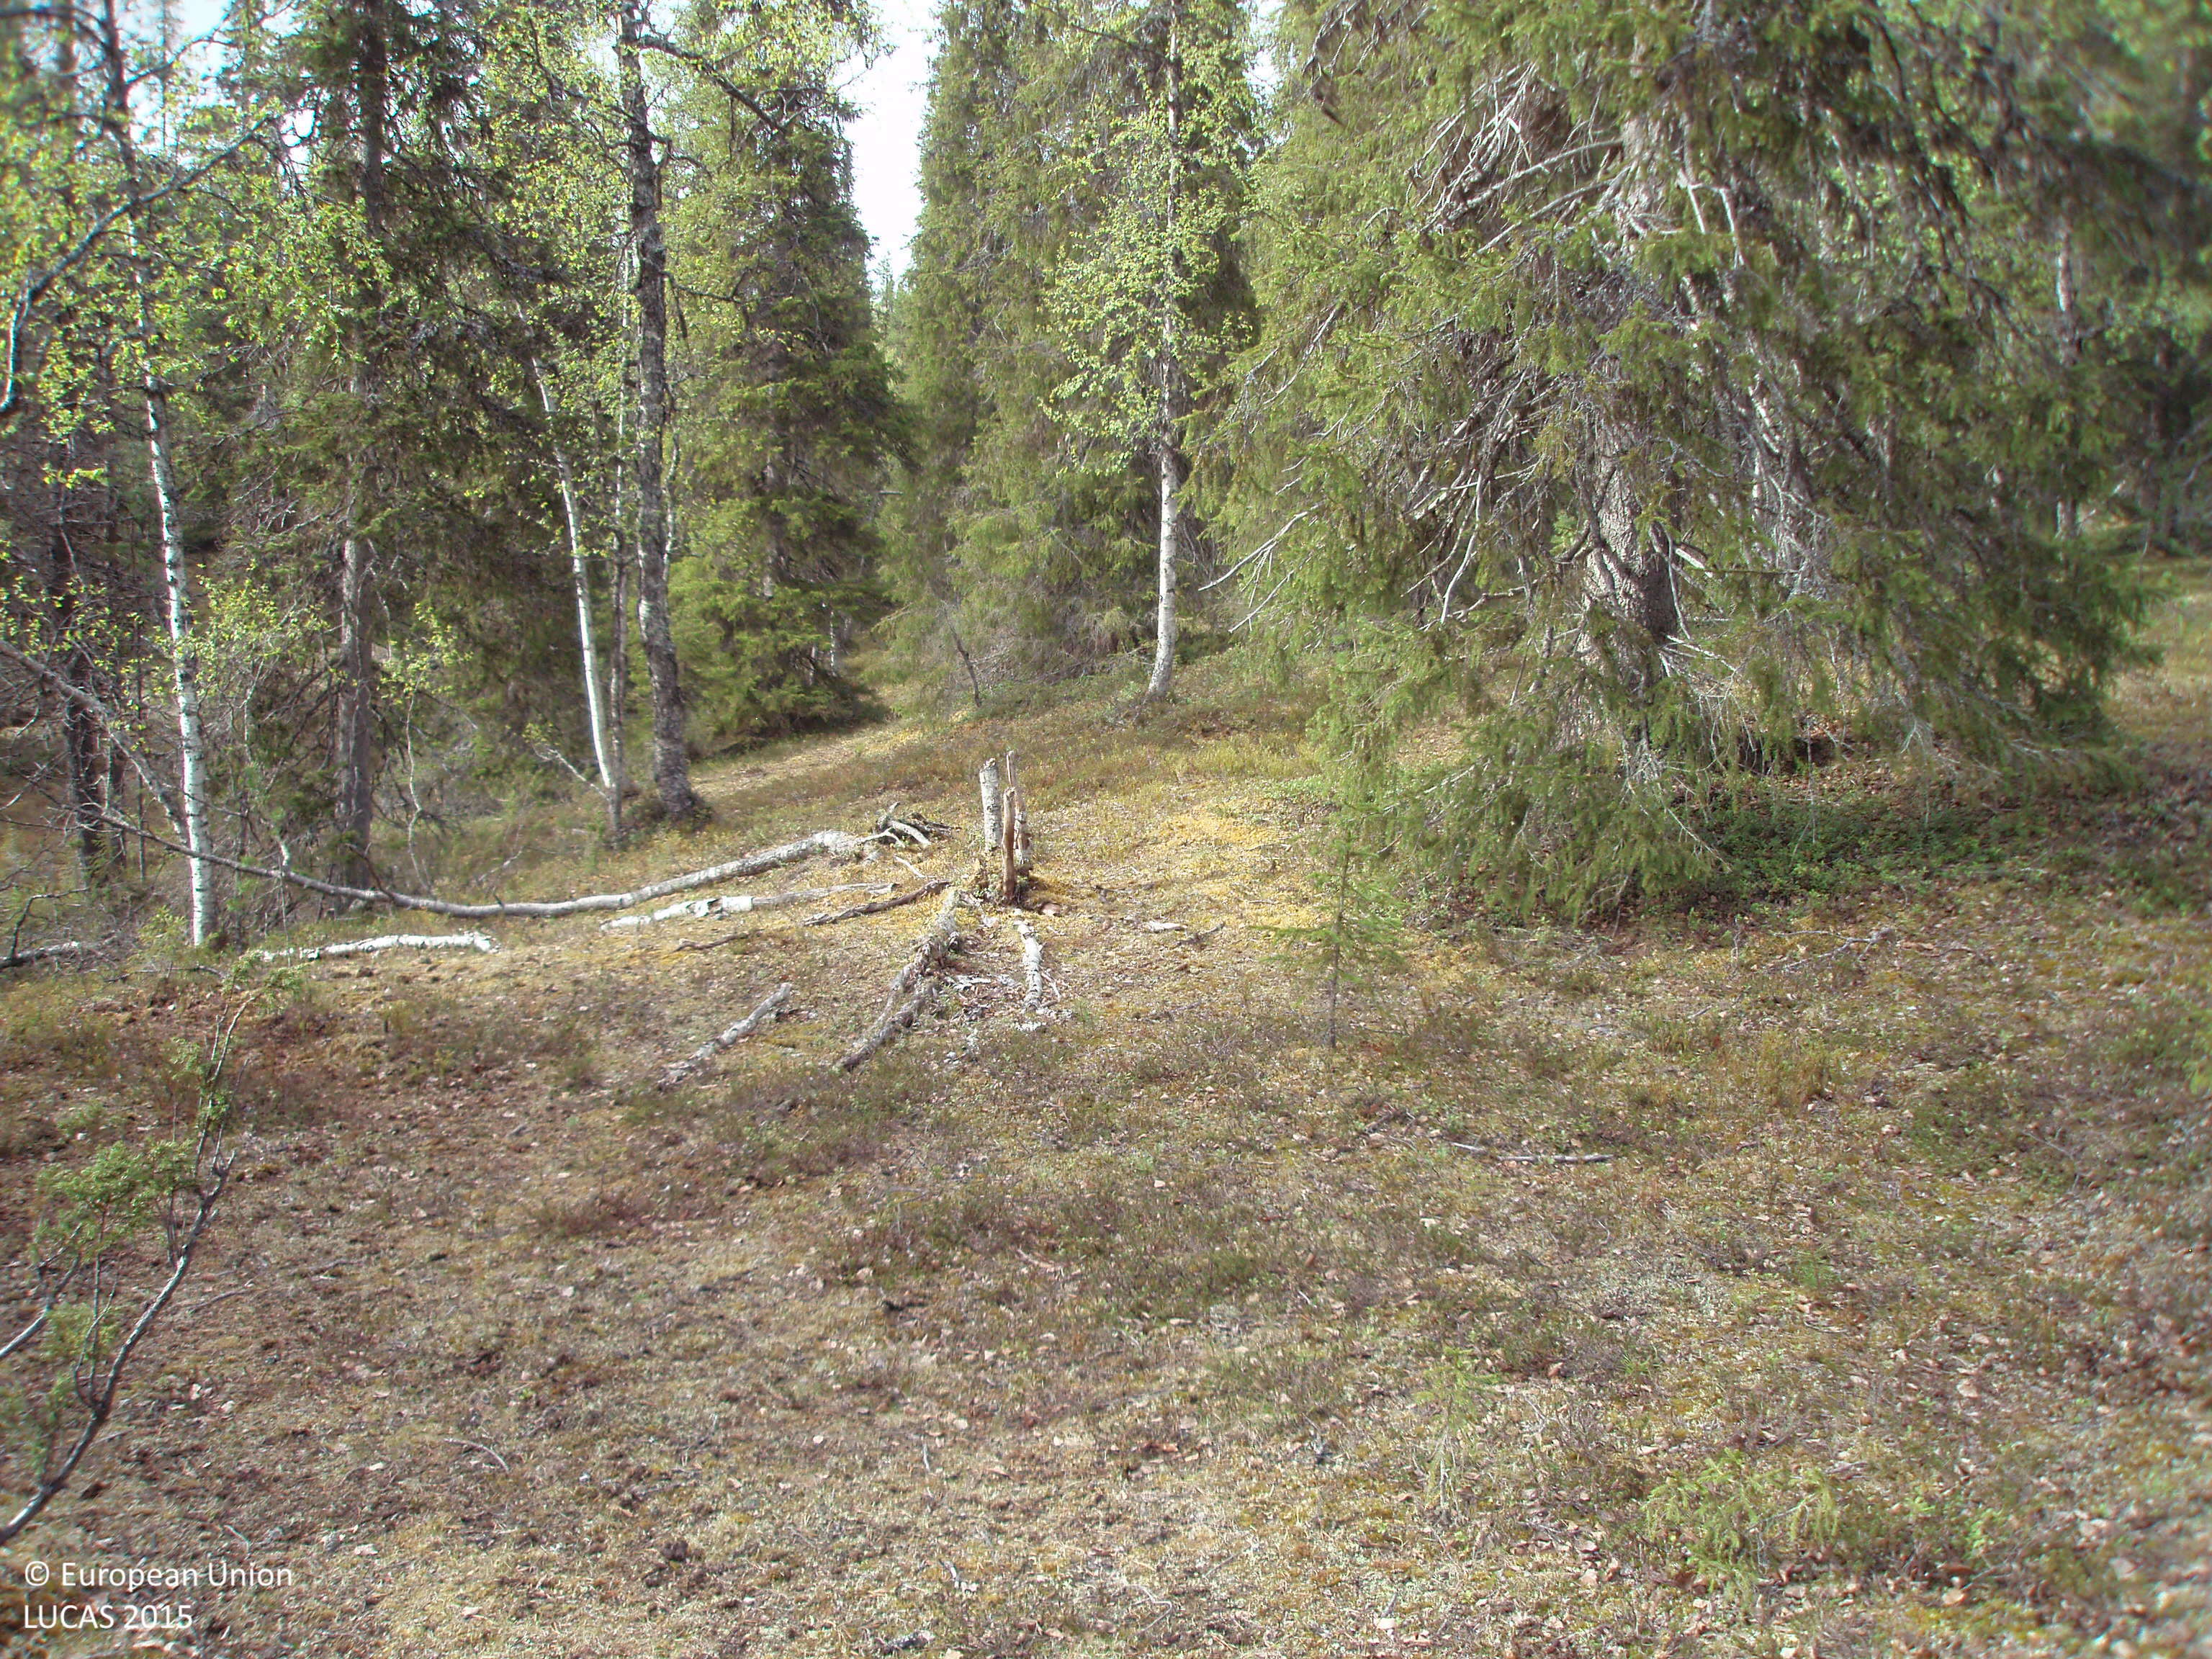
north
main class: Woodland
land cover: Other mixed woodland
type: boreal forest
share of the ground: 50 - 75 %
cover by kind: coniferous forest trees 50 %, broadleaved forest trees 20 %, shrubs 20 %, lichens and mosses 10 %
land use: Forestry
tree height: > 5 m
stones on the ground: 10 - 25 %
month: June
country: FI
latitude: 68.2769
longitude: 26.9936
